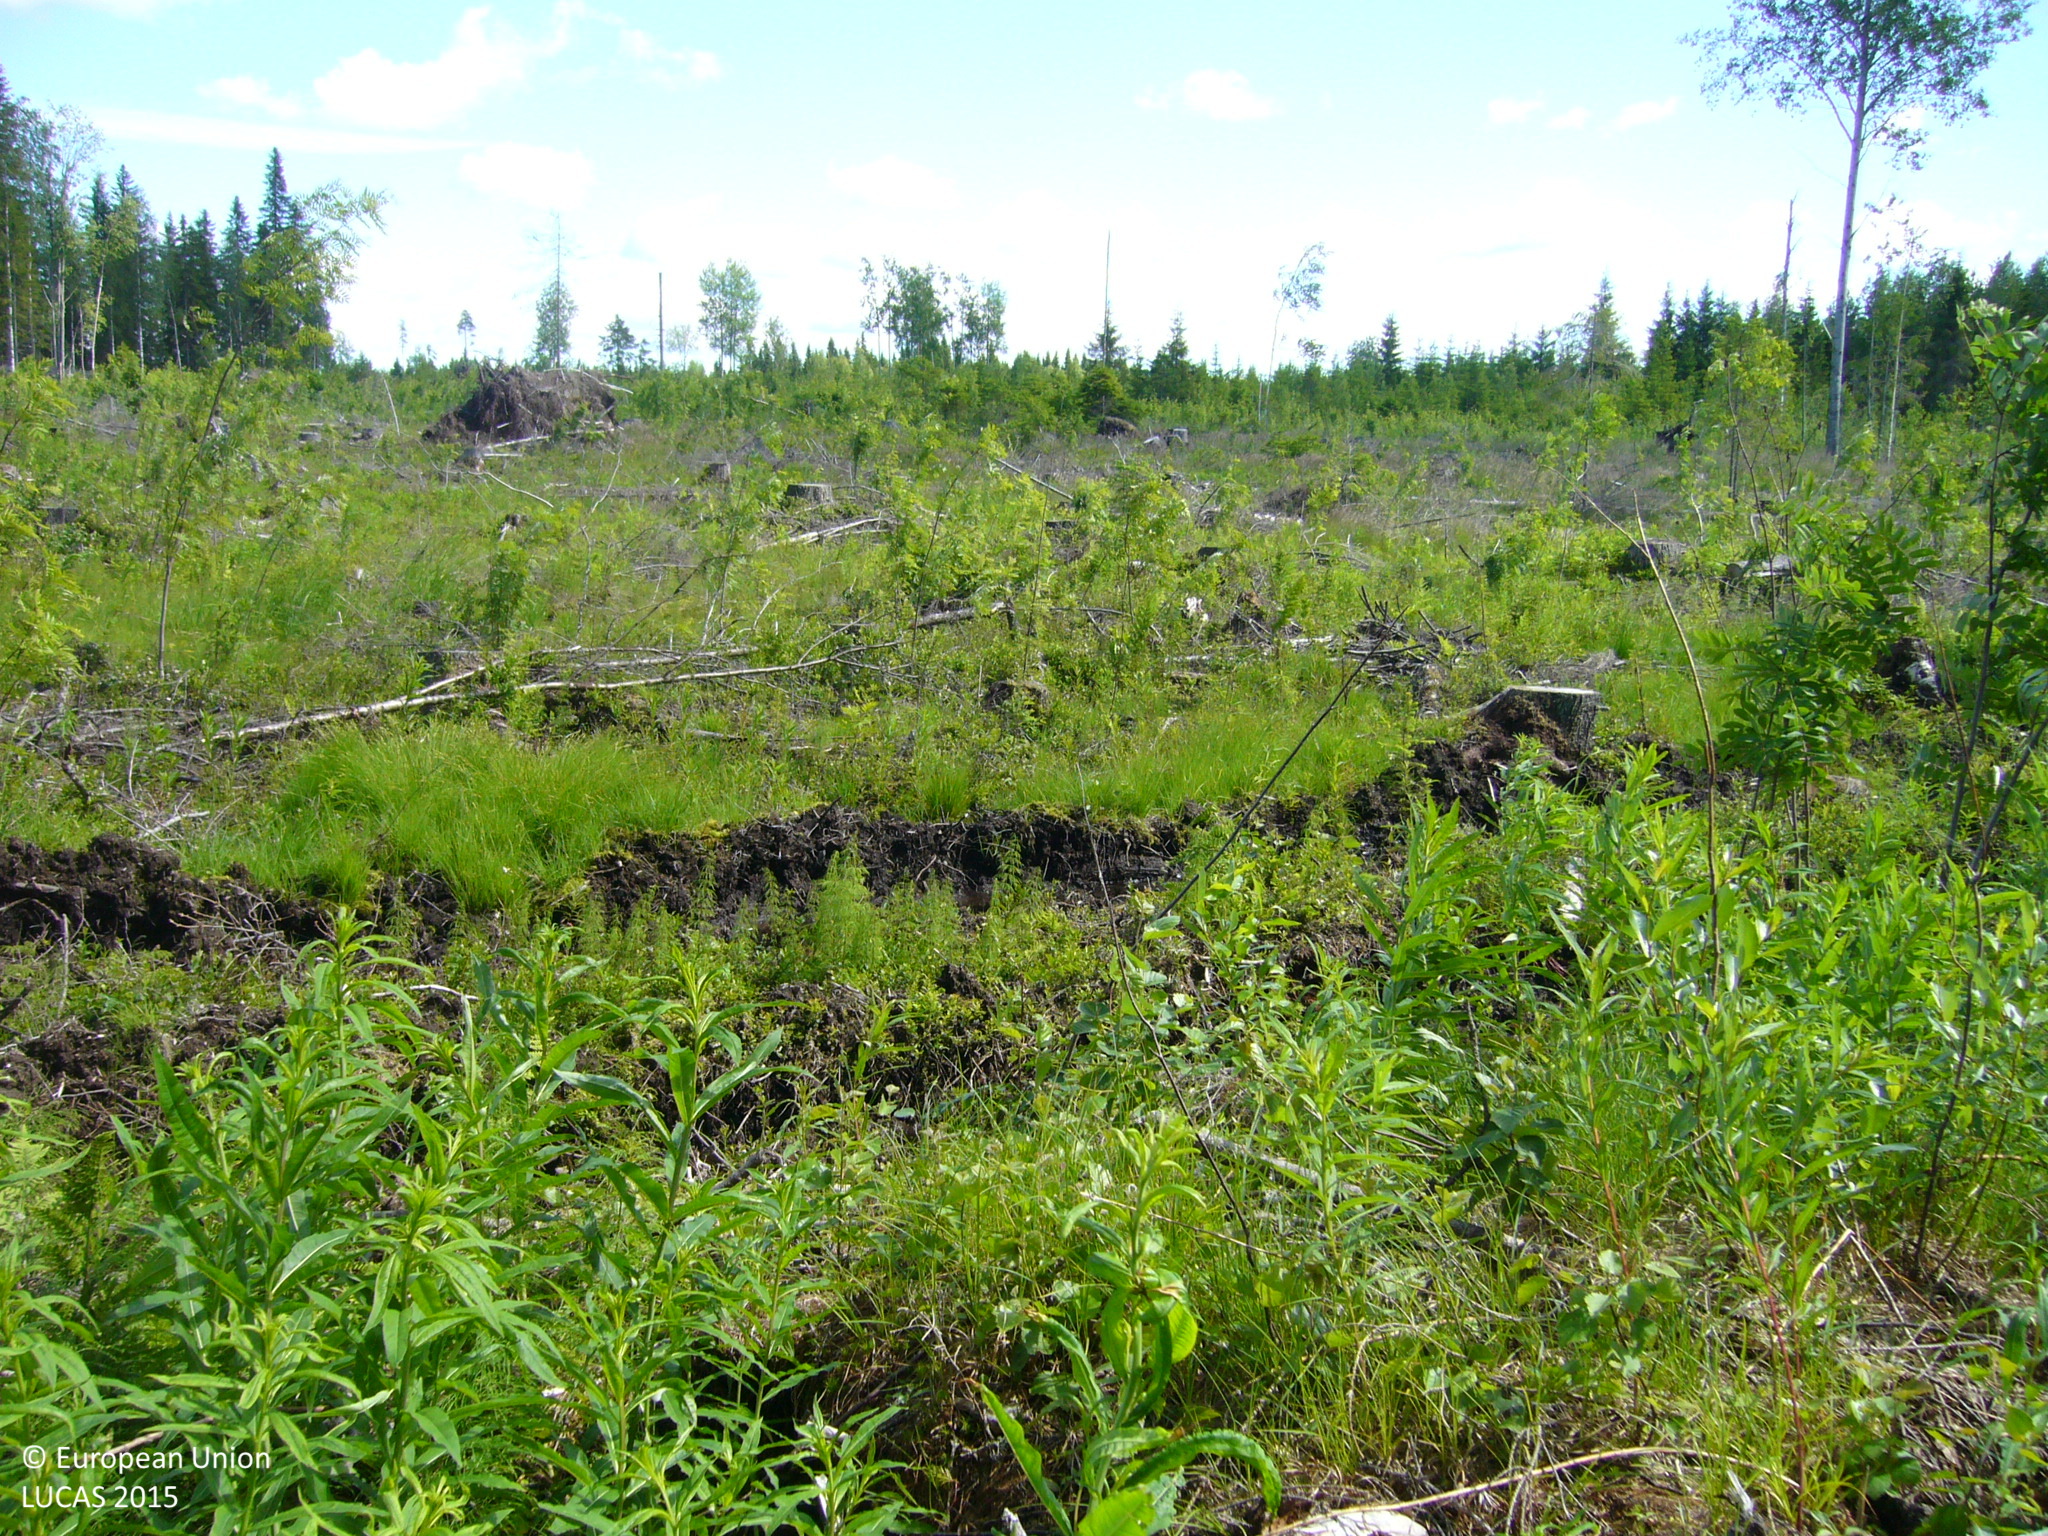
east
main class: Shrubland
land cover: Shrubland without tree cover
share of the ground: 10 - 25 %
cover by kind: herbaceous plants 50 %, shrubs 20 %, consolidated bare surface 10 %, unconsolidated bare surface 10 %
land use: Forestry
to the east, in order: Shrubland without tree cover; Tracks; Shrubland without tree cover; Ditches and canals; Shrubland without tree cover; Ditches and canals; Shrubland without tree cover; Ditches and canals; Shrubland without tree cover; Tracks; Spruce dominated mixed woodland; Spruce dominated coniferous woodland
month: July
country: FI
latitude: 63.5387
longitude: 26.0247
